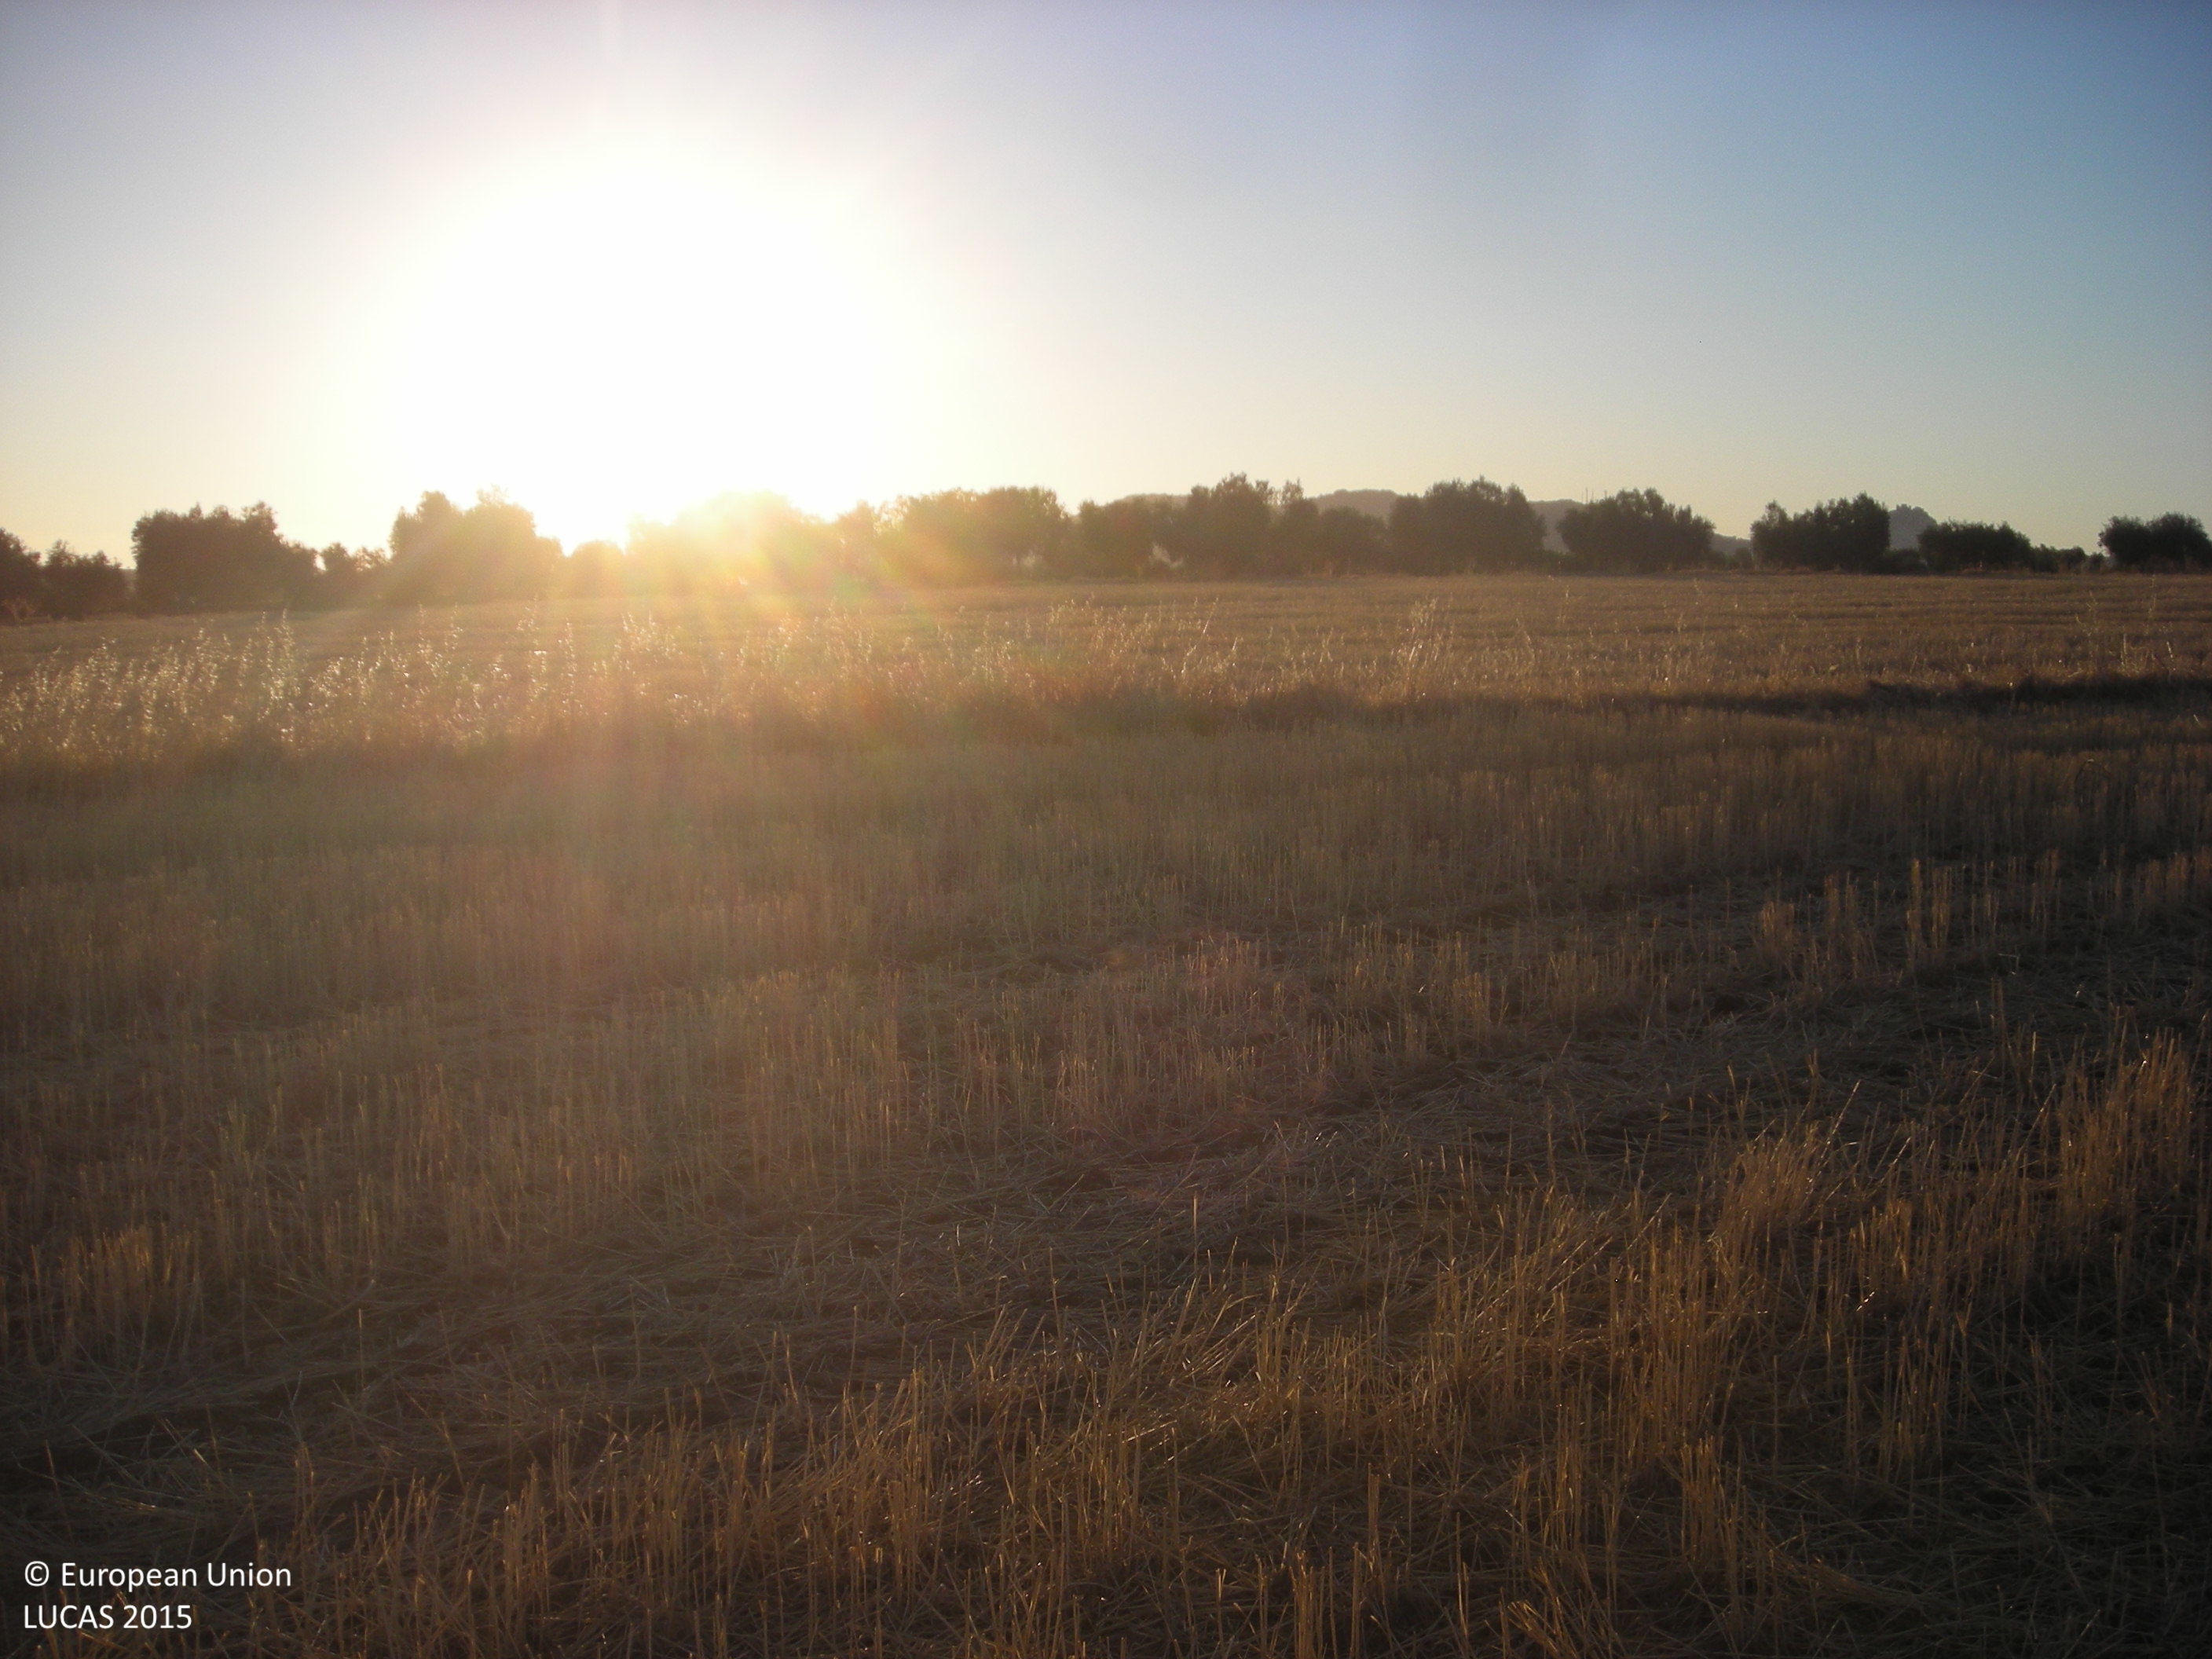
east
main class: Cropland
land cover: Common wheat
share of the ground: > 75 %
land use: Agriculture (excluding fallow land and kitchen gardens)
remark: Harvested field
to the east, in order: Common wheat; Grass margins; Common wheat; Grass margins; Other bare soil; Olive groves; Tracks; Other root crops
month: July
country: ES
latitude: 38.9026
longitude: -5.8103
